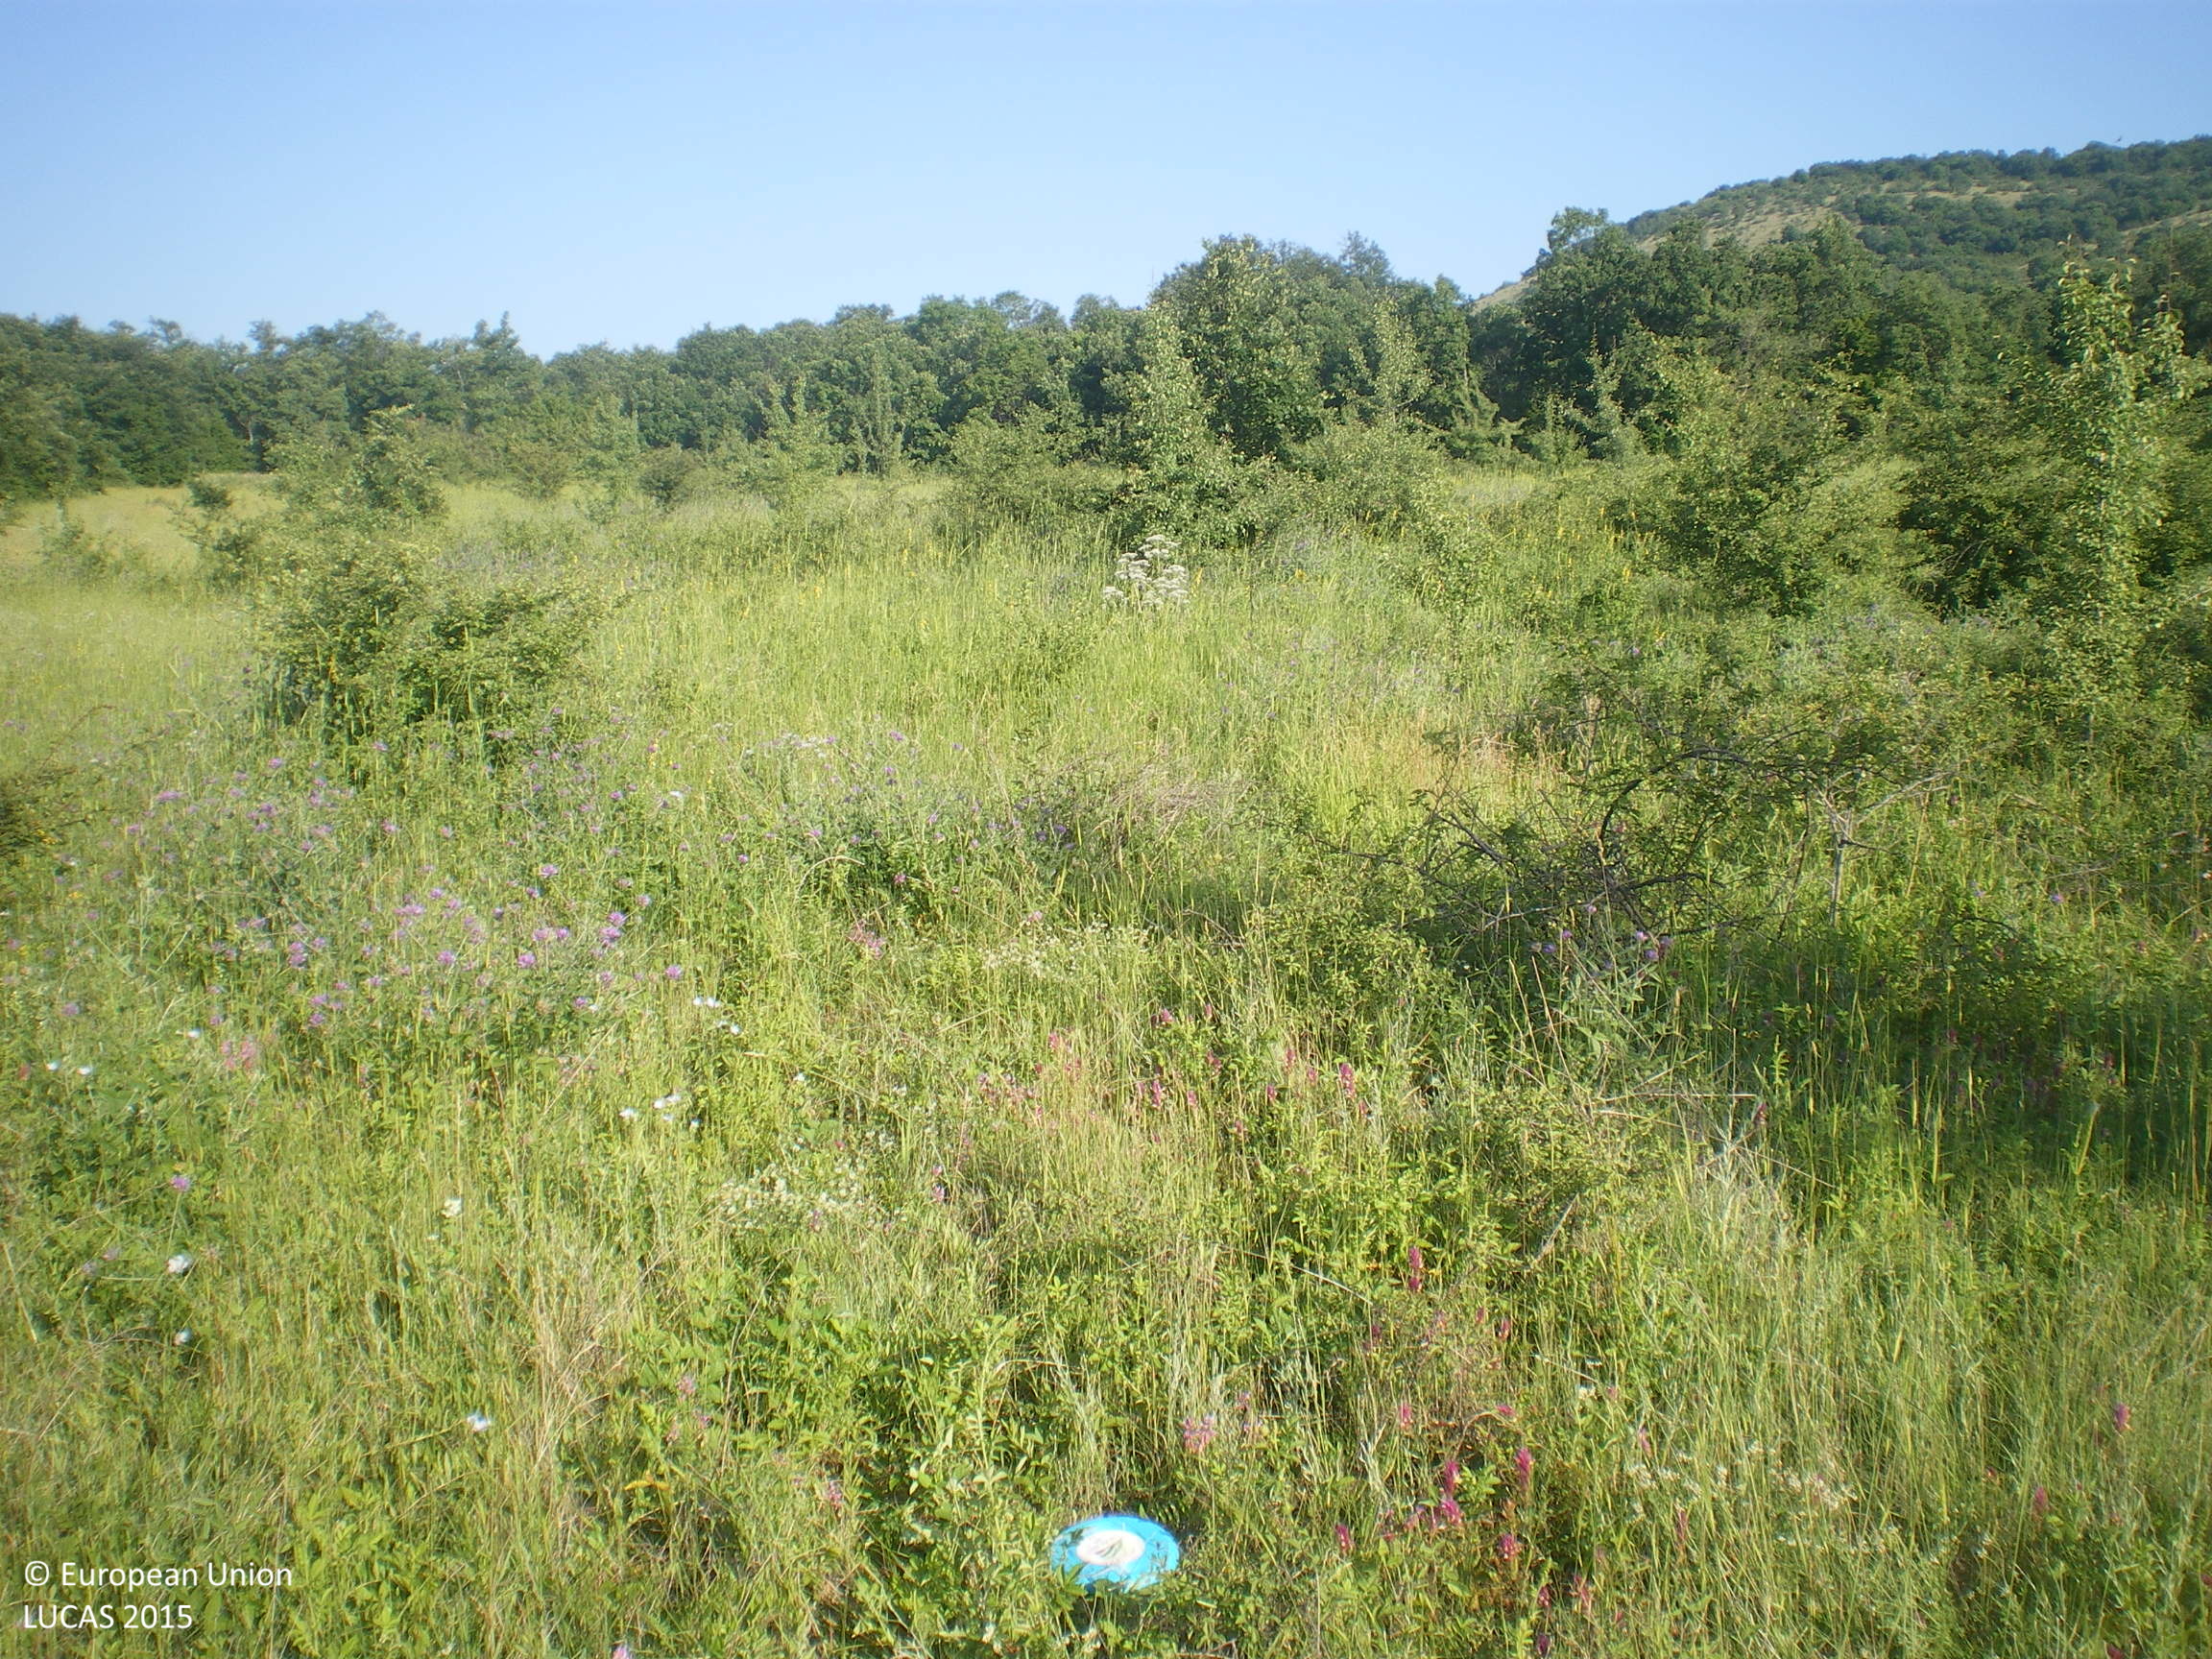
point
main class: Grassland
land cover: Grassland with sparse tree/shrub cover
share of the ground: > 75 %
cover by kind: herbaceous plants 90 %, broadleaved forest trees 5 %, shrubs 5 %
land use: Forestry
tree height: < 5 m
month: June
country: BG
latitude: 42.3929
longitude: 25.1123
